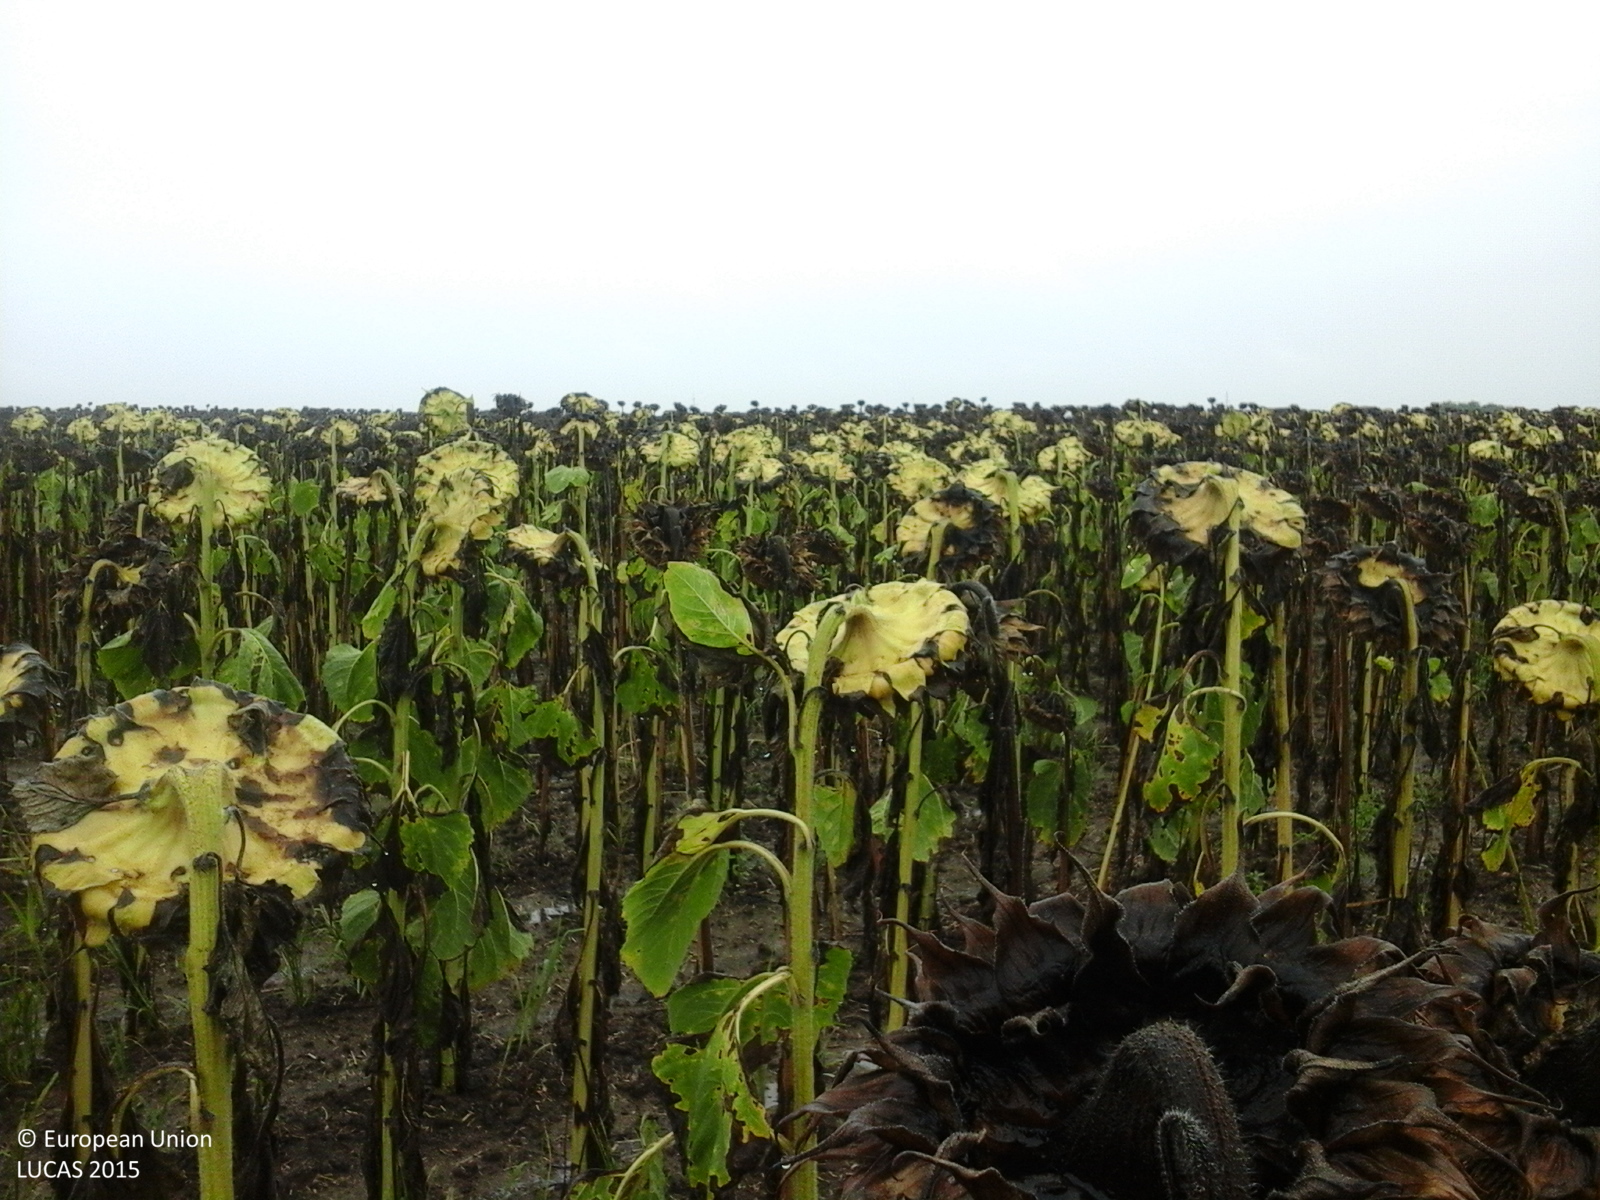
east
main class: Cropland
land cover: Sunflower
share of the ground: > 75 %
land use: Agriculture (excluding fallow land and kitchen gardens)
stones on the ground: 10 - 25 %
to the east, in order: Sunflower; Common wheat
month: August
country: RO
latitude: 45.6620
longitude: 21.1048
